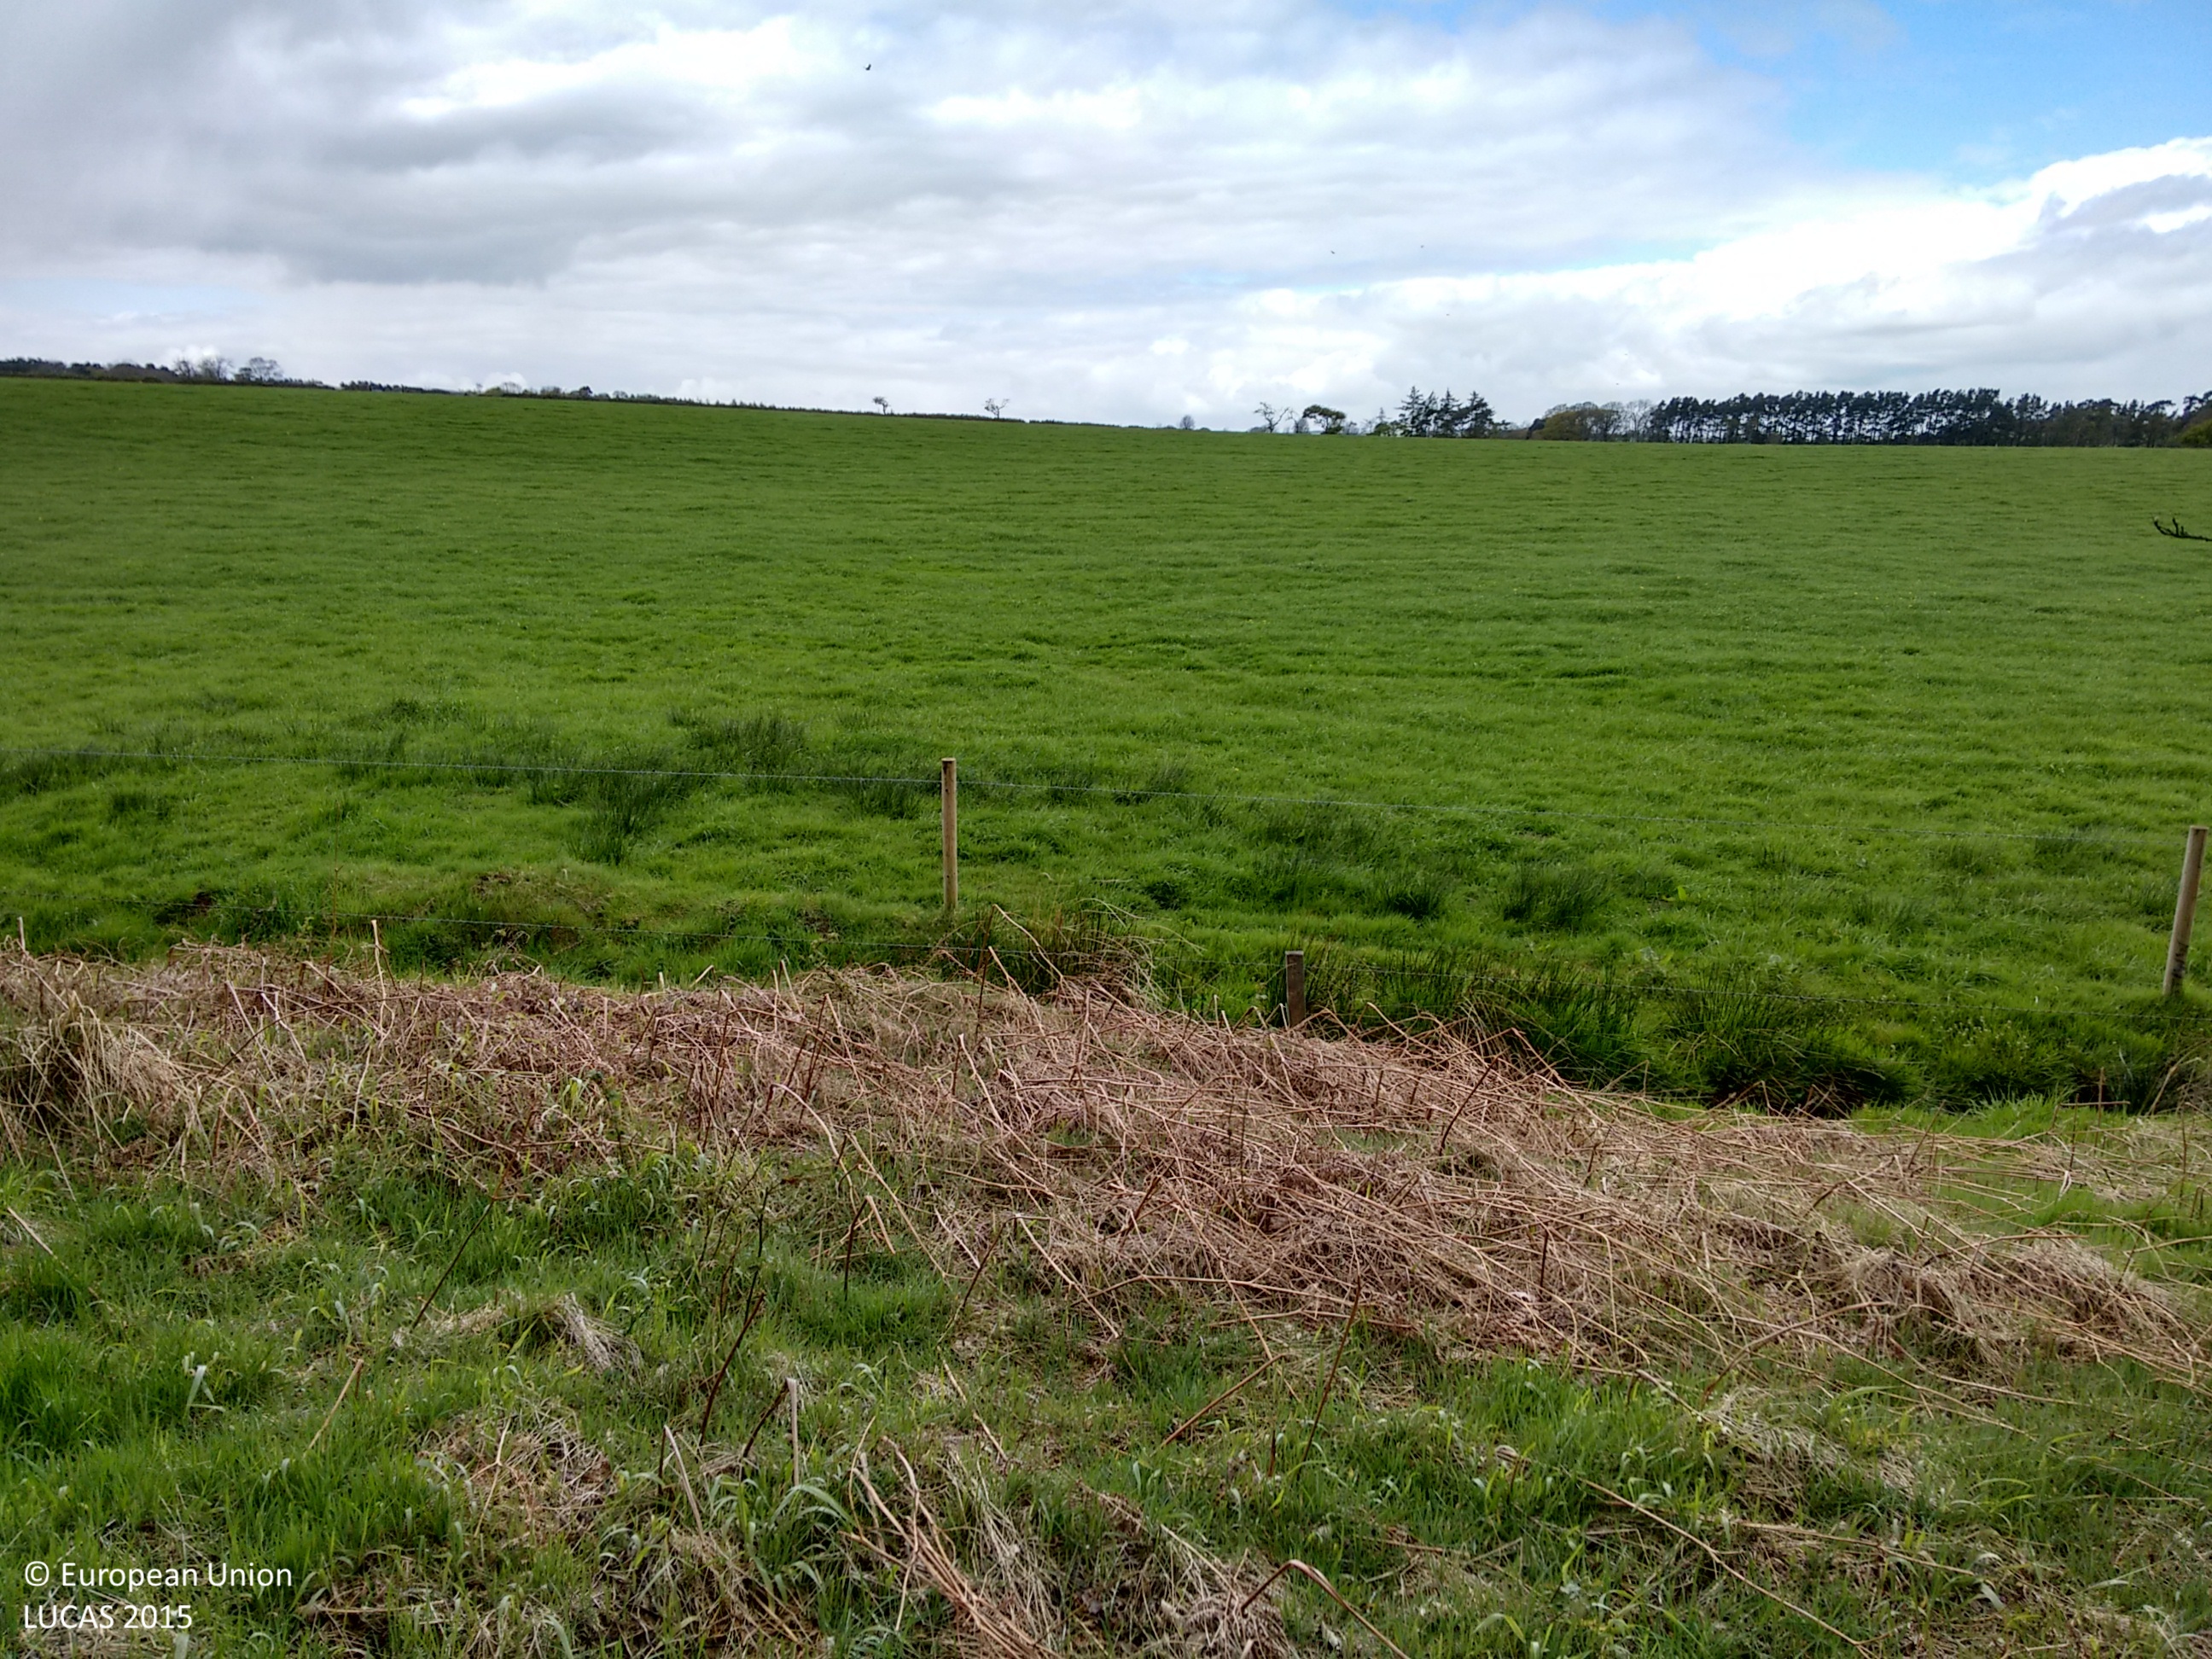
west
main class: Woodland
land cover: Broadleaved woodland
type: acidophilous oak and oak-birch forest
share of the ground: > 75 %
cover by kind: broadleaved forest trees 100 %
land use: Semi-natural and natural areas not in use
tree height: > 5 m
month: May
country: GB
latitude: 54.9077
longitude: -2.0498
